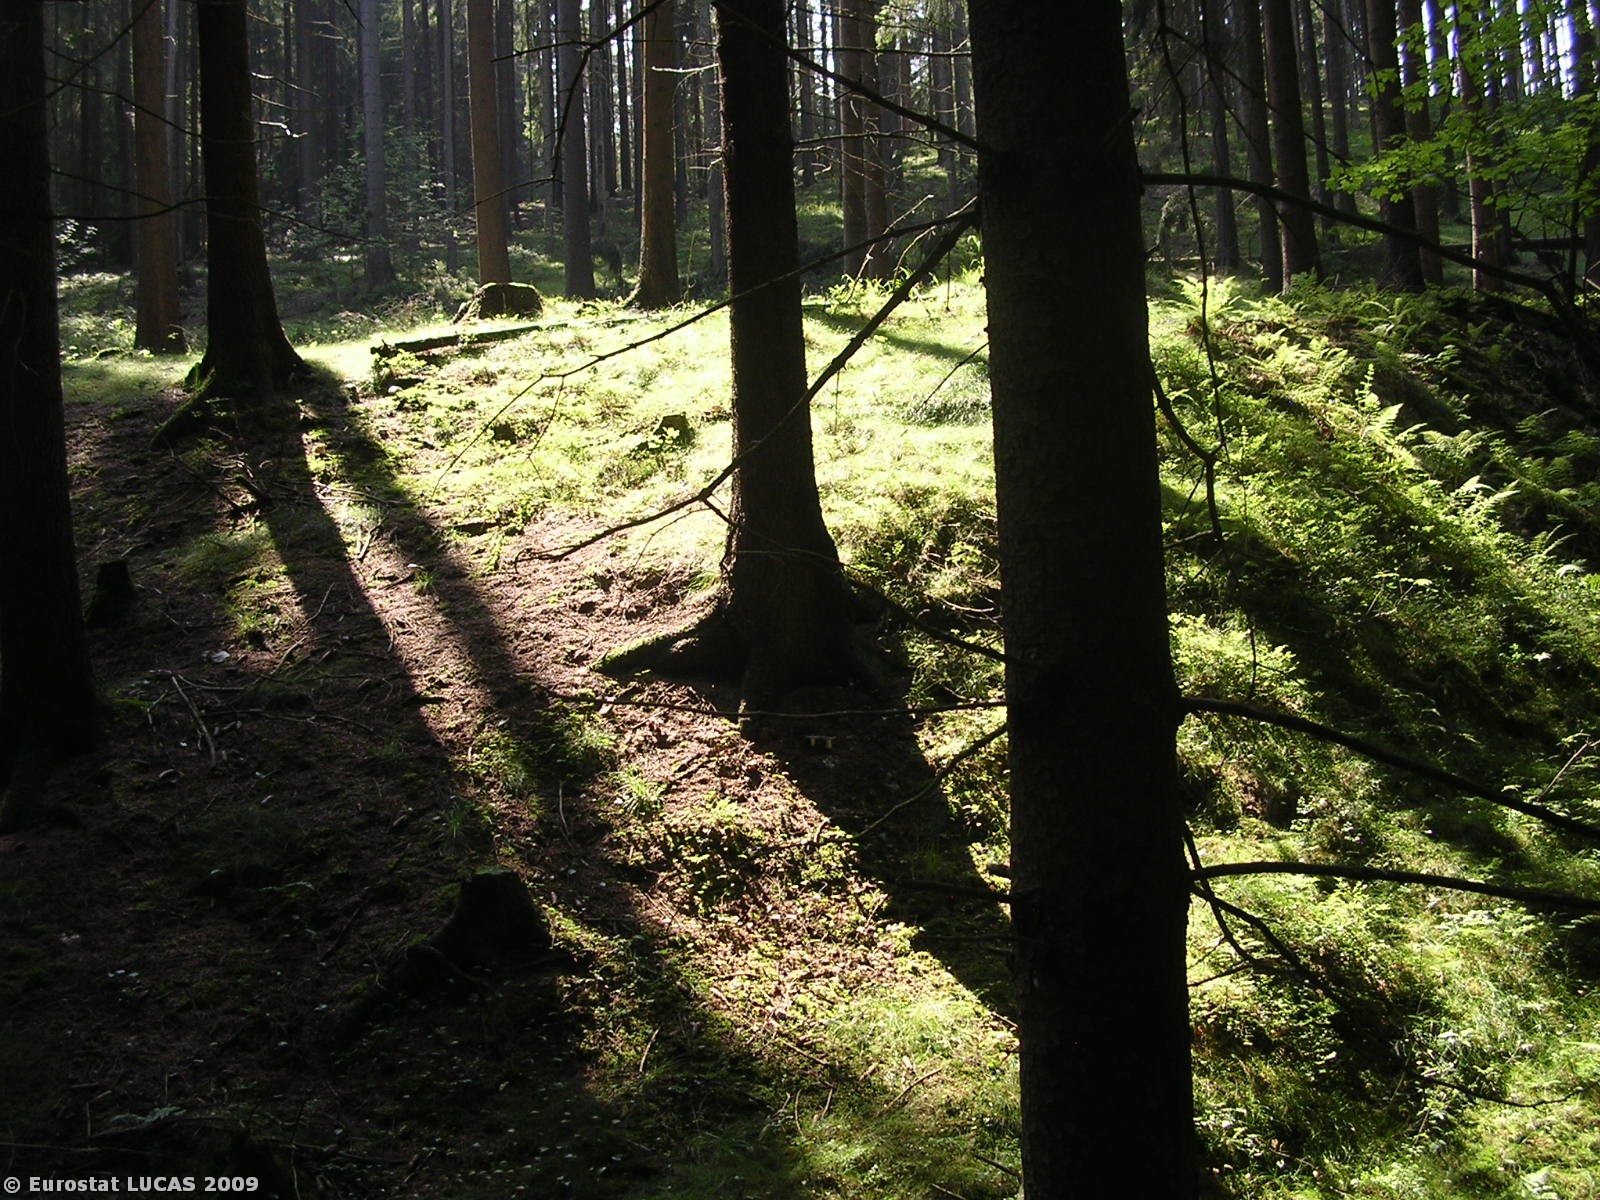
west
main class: Woodland
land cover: Coniferous woodland
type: hemiboreal forest and nemoral coniferous forest and mixed broadleaved-coniferous forest
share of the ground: > 75 %
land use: Forestry
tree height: > 5 m
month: July
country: CZ
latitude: 50.6705
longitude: 14.9693
